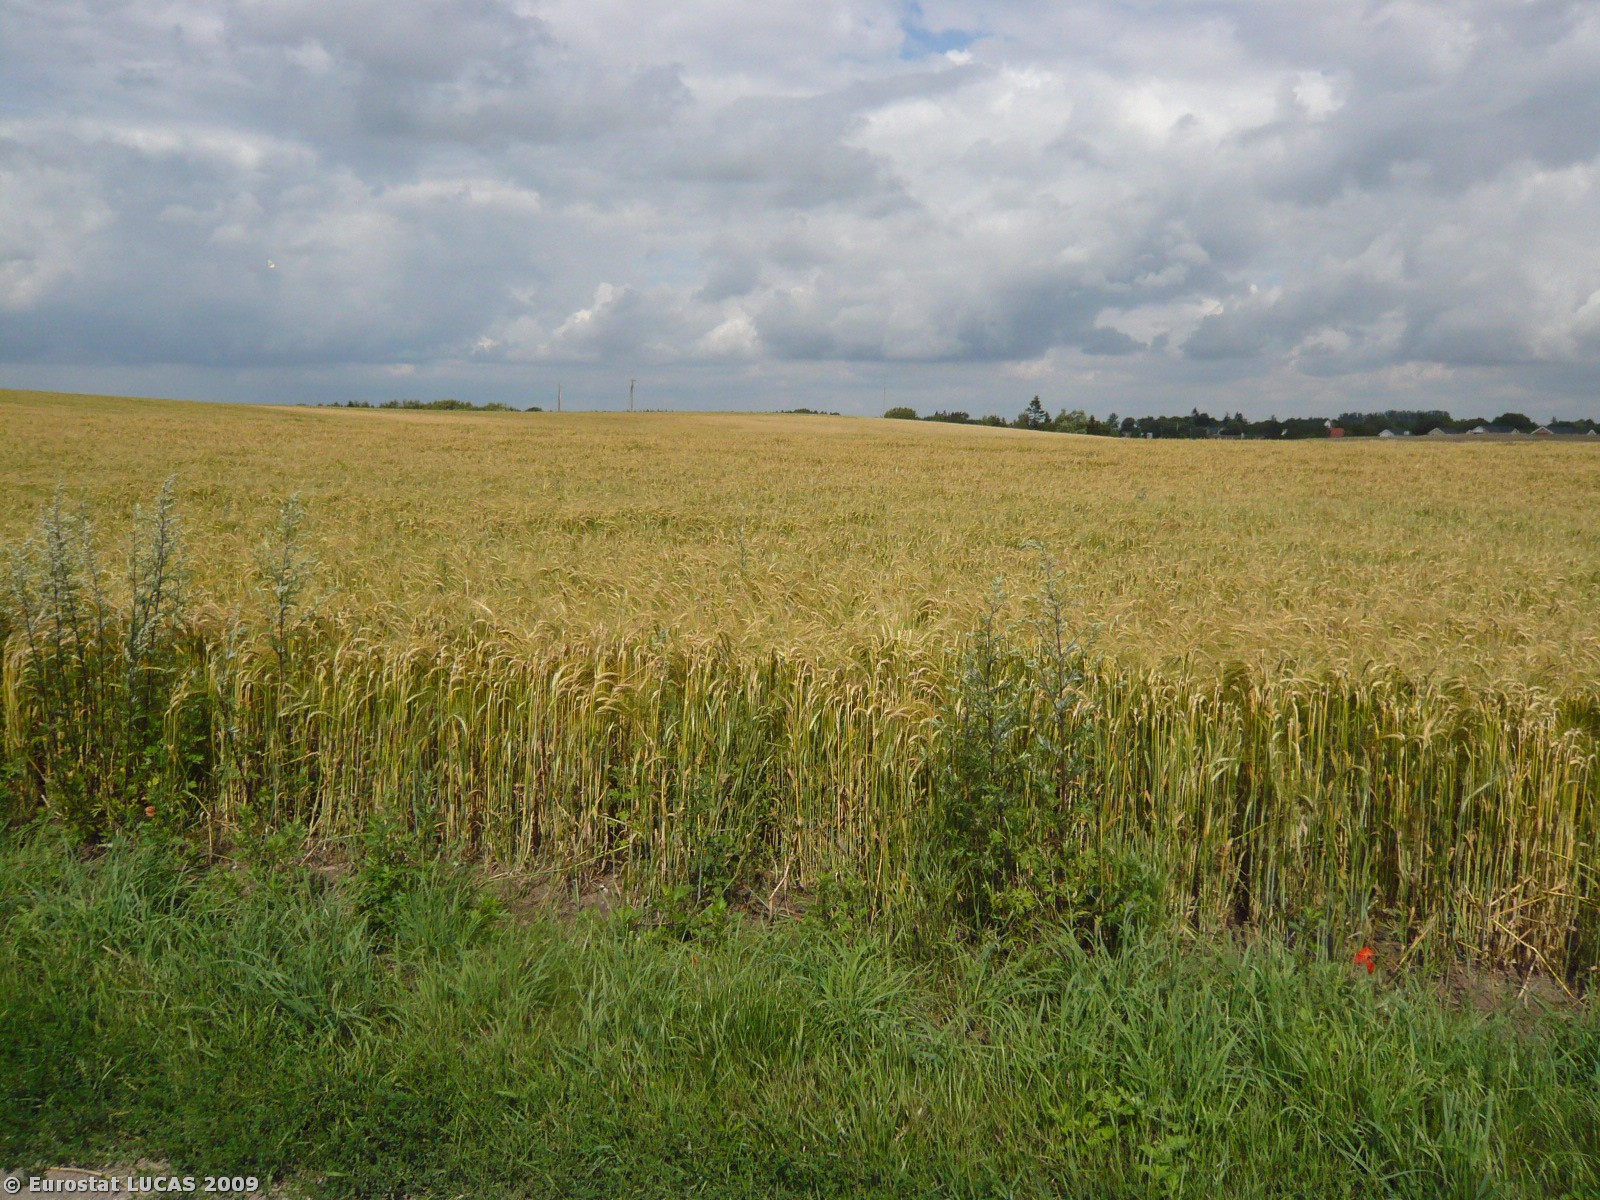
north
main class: Cropland
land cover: Rape and turnip rape
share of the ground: > 75 %
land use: Agriculture (excluding fallow land and kitchen gardens)
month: July
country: DK
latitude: 55.5092
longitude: 11.8511
